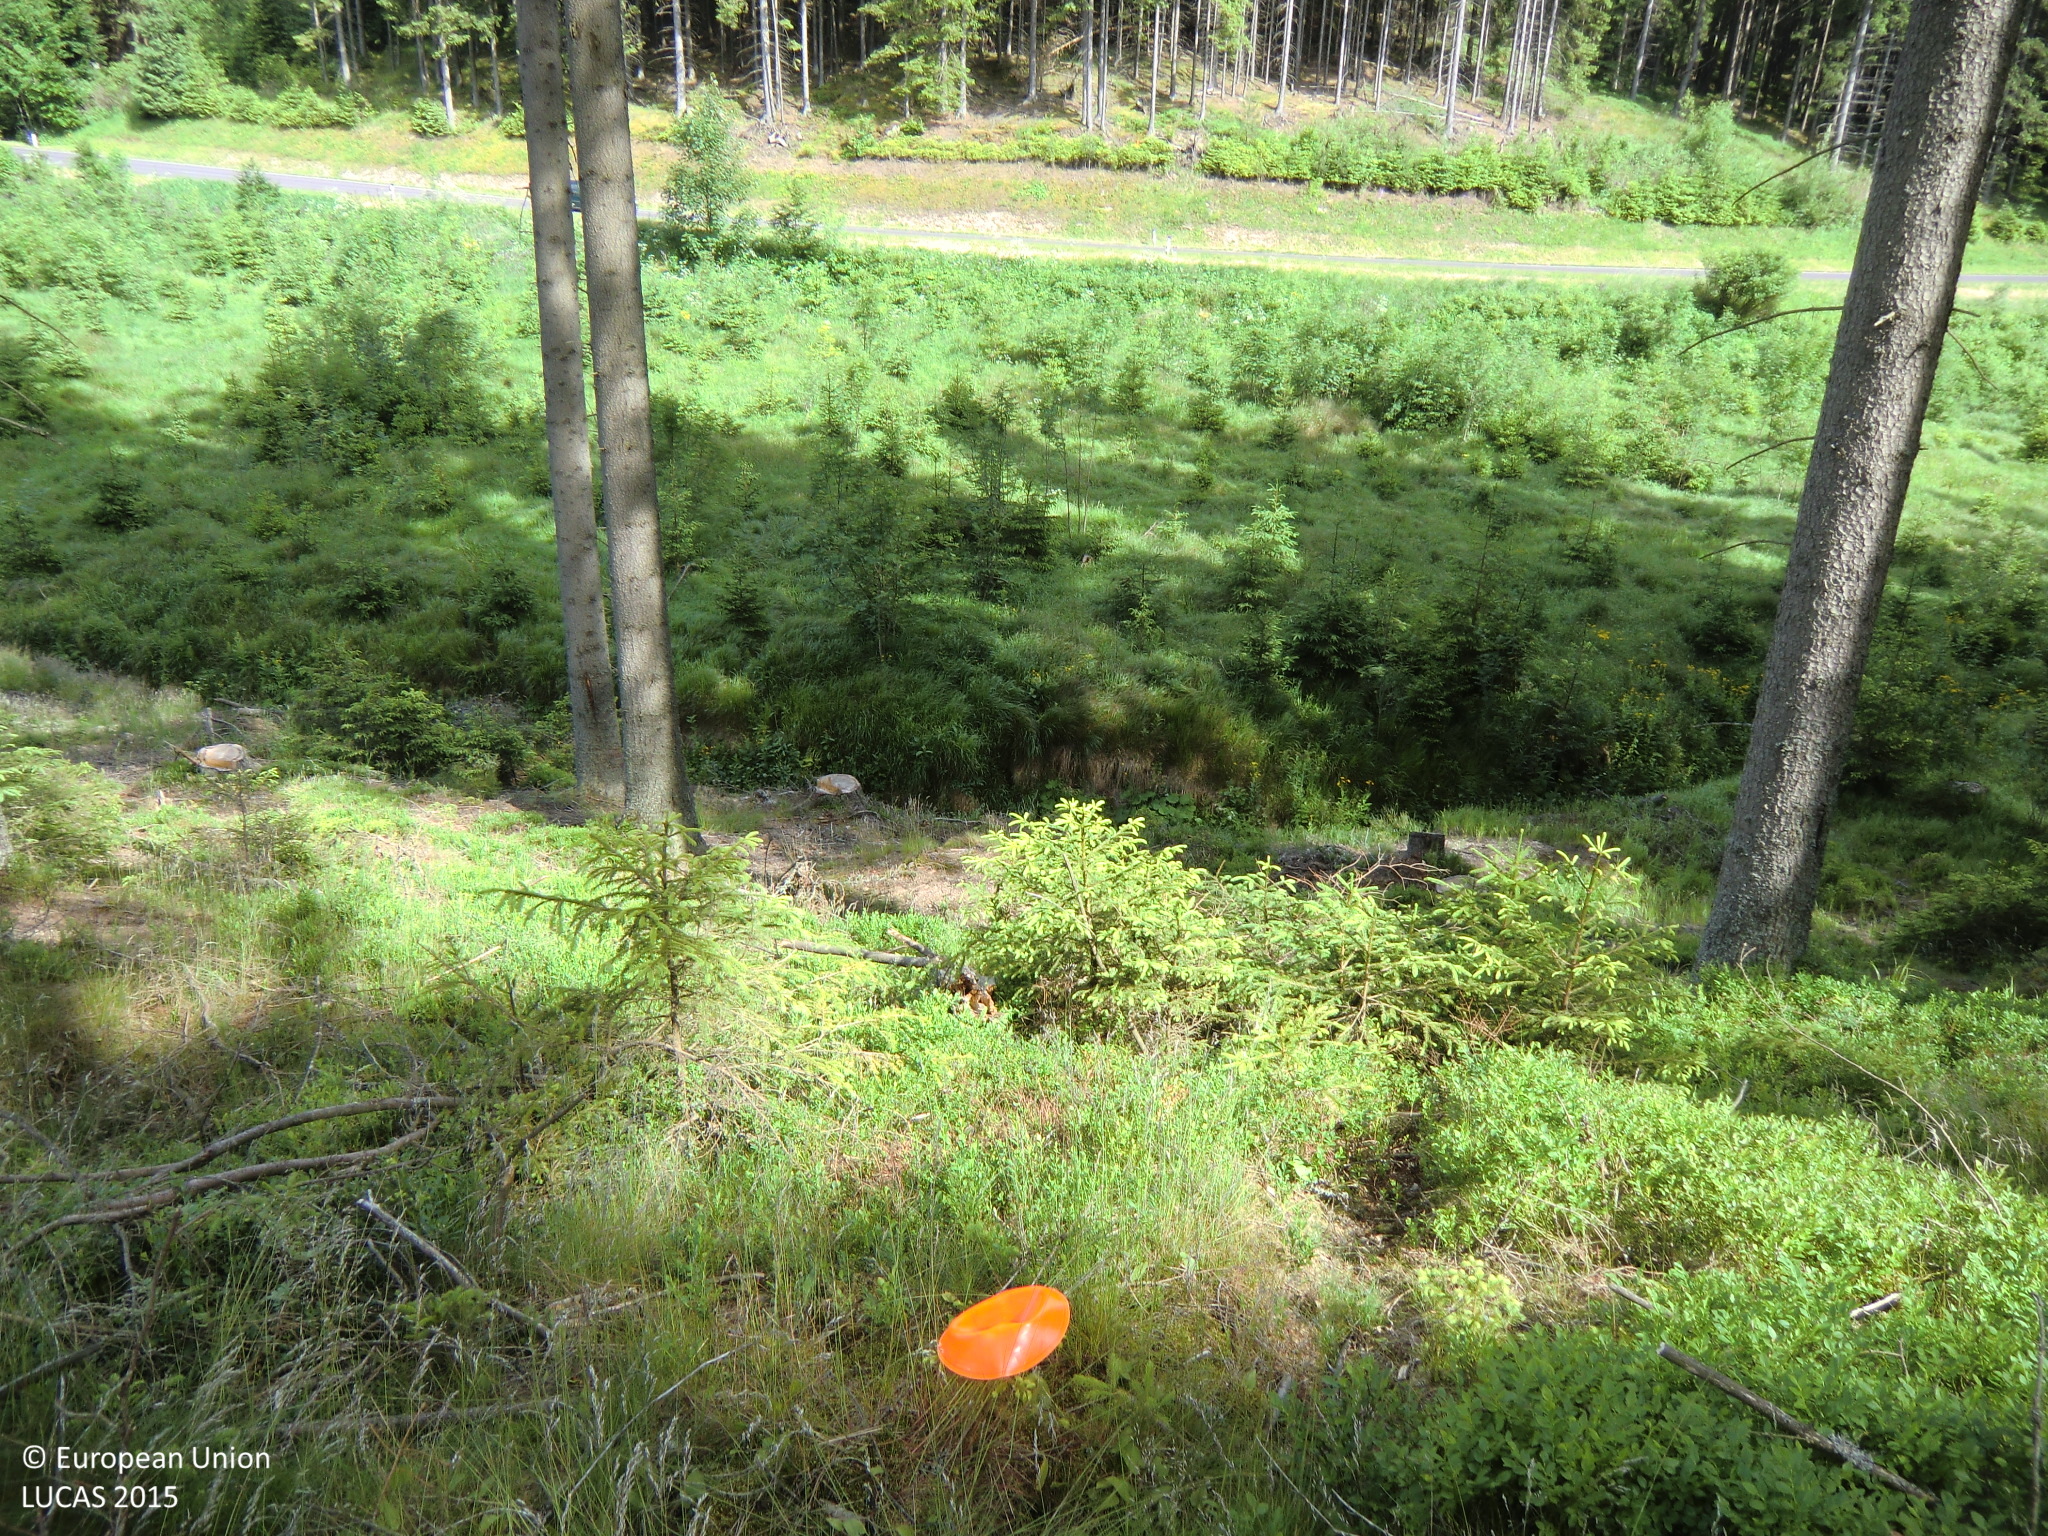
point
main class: Woodland
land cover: Spruce dominated coniferous woodland
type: hemiboreal forest and nemoral coniferous forest and mixed broadleaved-coniferous forest
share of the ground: 50 - 75 %
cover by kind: coniferous forest trees 70 %, shrubs 15 %, herbaceous plants 15 %
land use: Forestry
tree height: > 5 m
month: June
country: AT
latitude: 48.5500
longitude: 14.8376
